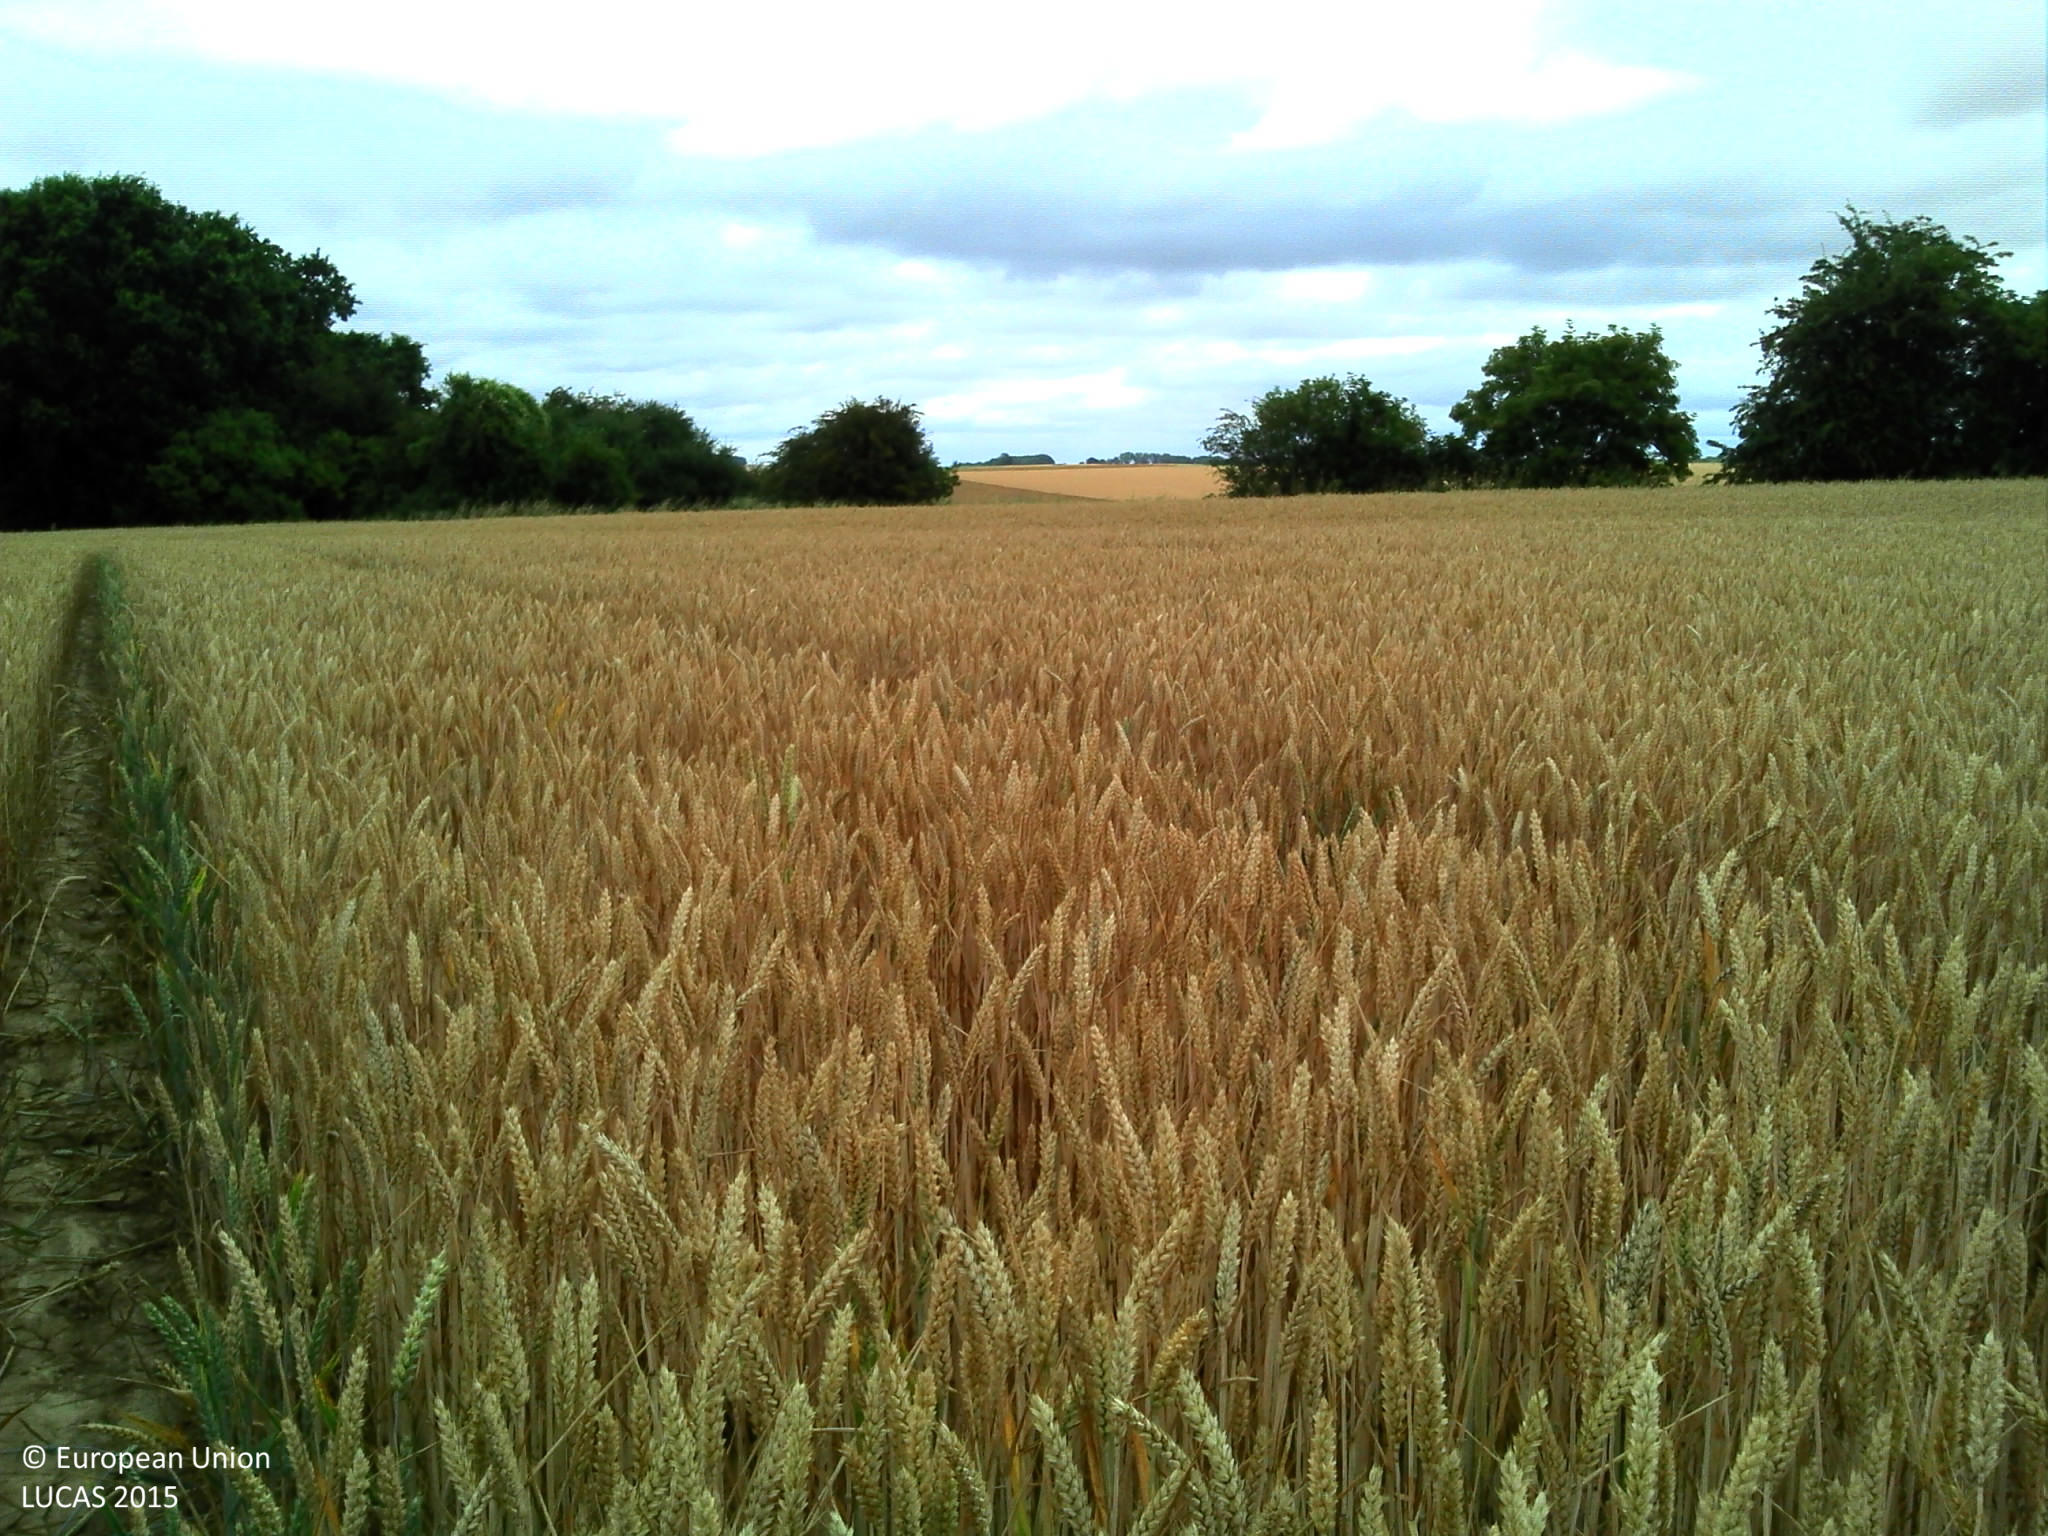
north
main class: Cropland
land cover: Common wheat
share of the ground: > 75 %
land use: Agriculture (excluding fallow land and kitchen gardens)
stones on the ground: < 10 %
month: July
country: FR
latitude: 50.0365
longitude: 3.2198
